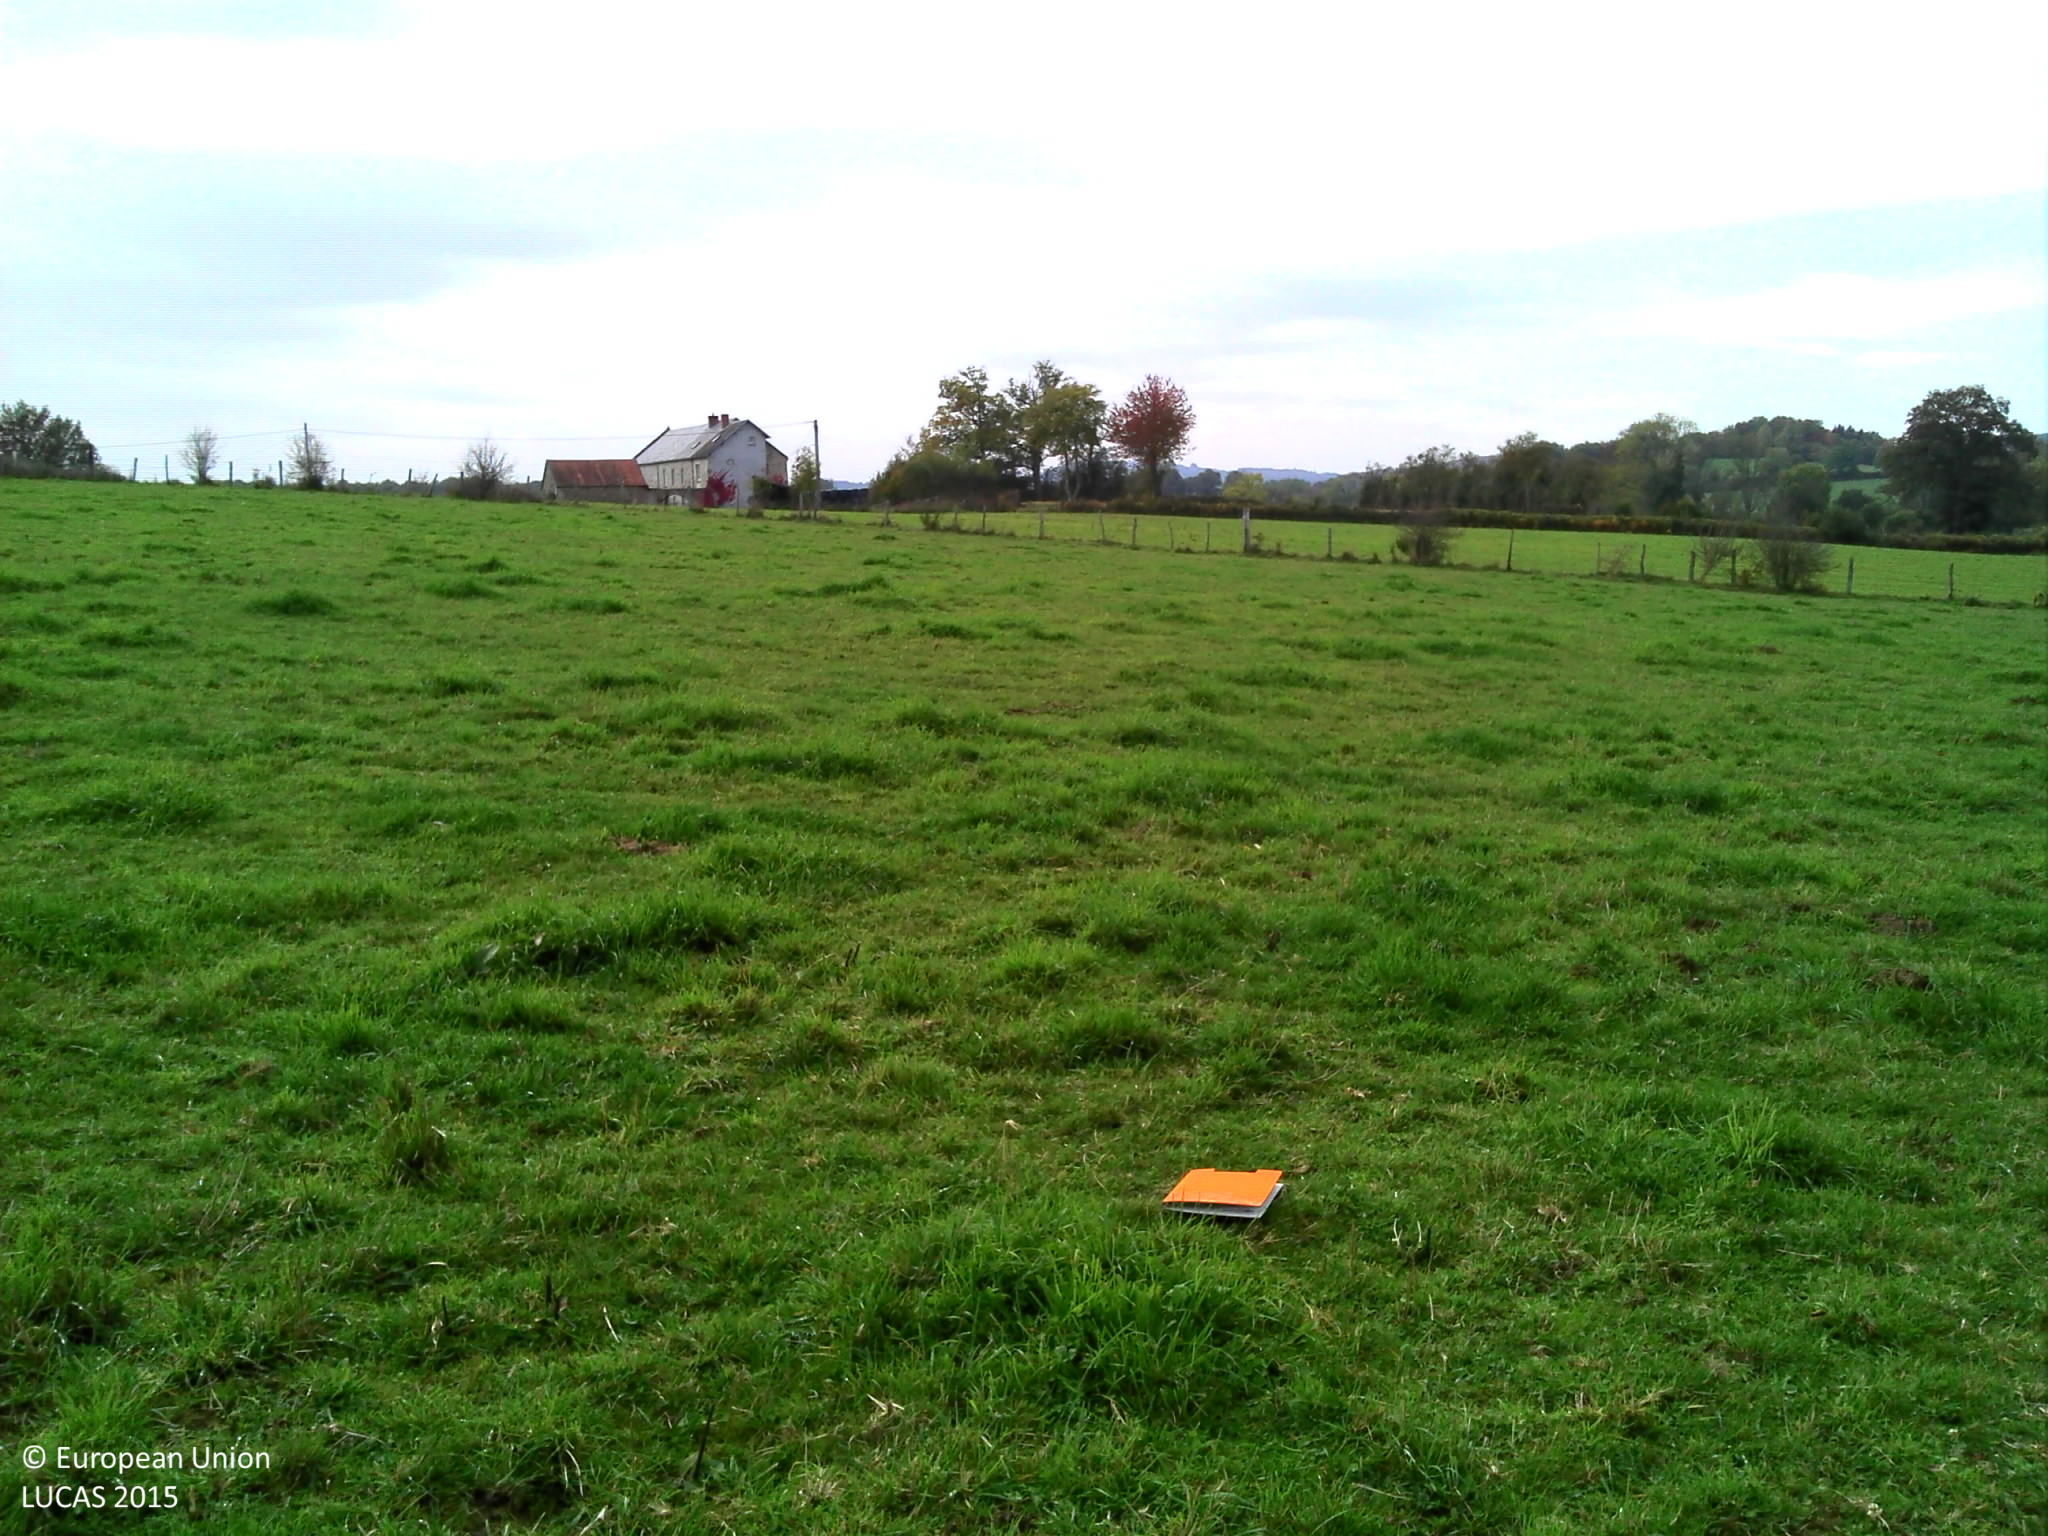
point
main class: Grassland
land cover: Grassland without tree/shrub cover
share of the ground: > 75 %
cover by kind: herbaceous plants 100 %
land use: Agriculture (excluding fallow land and kitchen gardens)
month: October
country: FR
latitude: 46.0737
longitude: 2.8218
